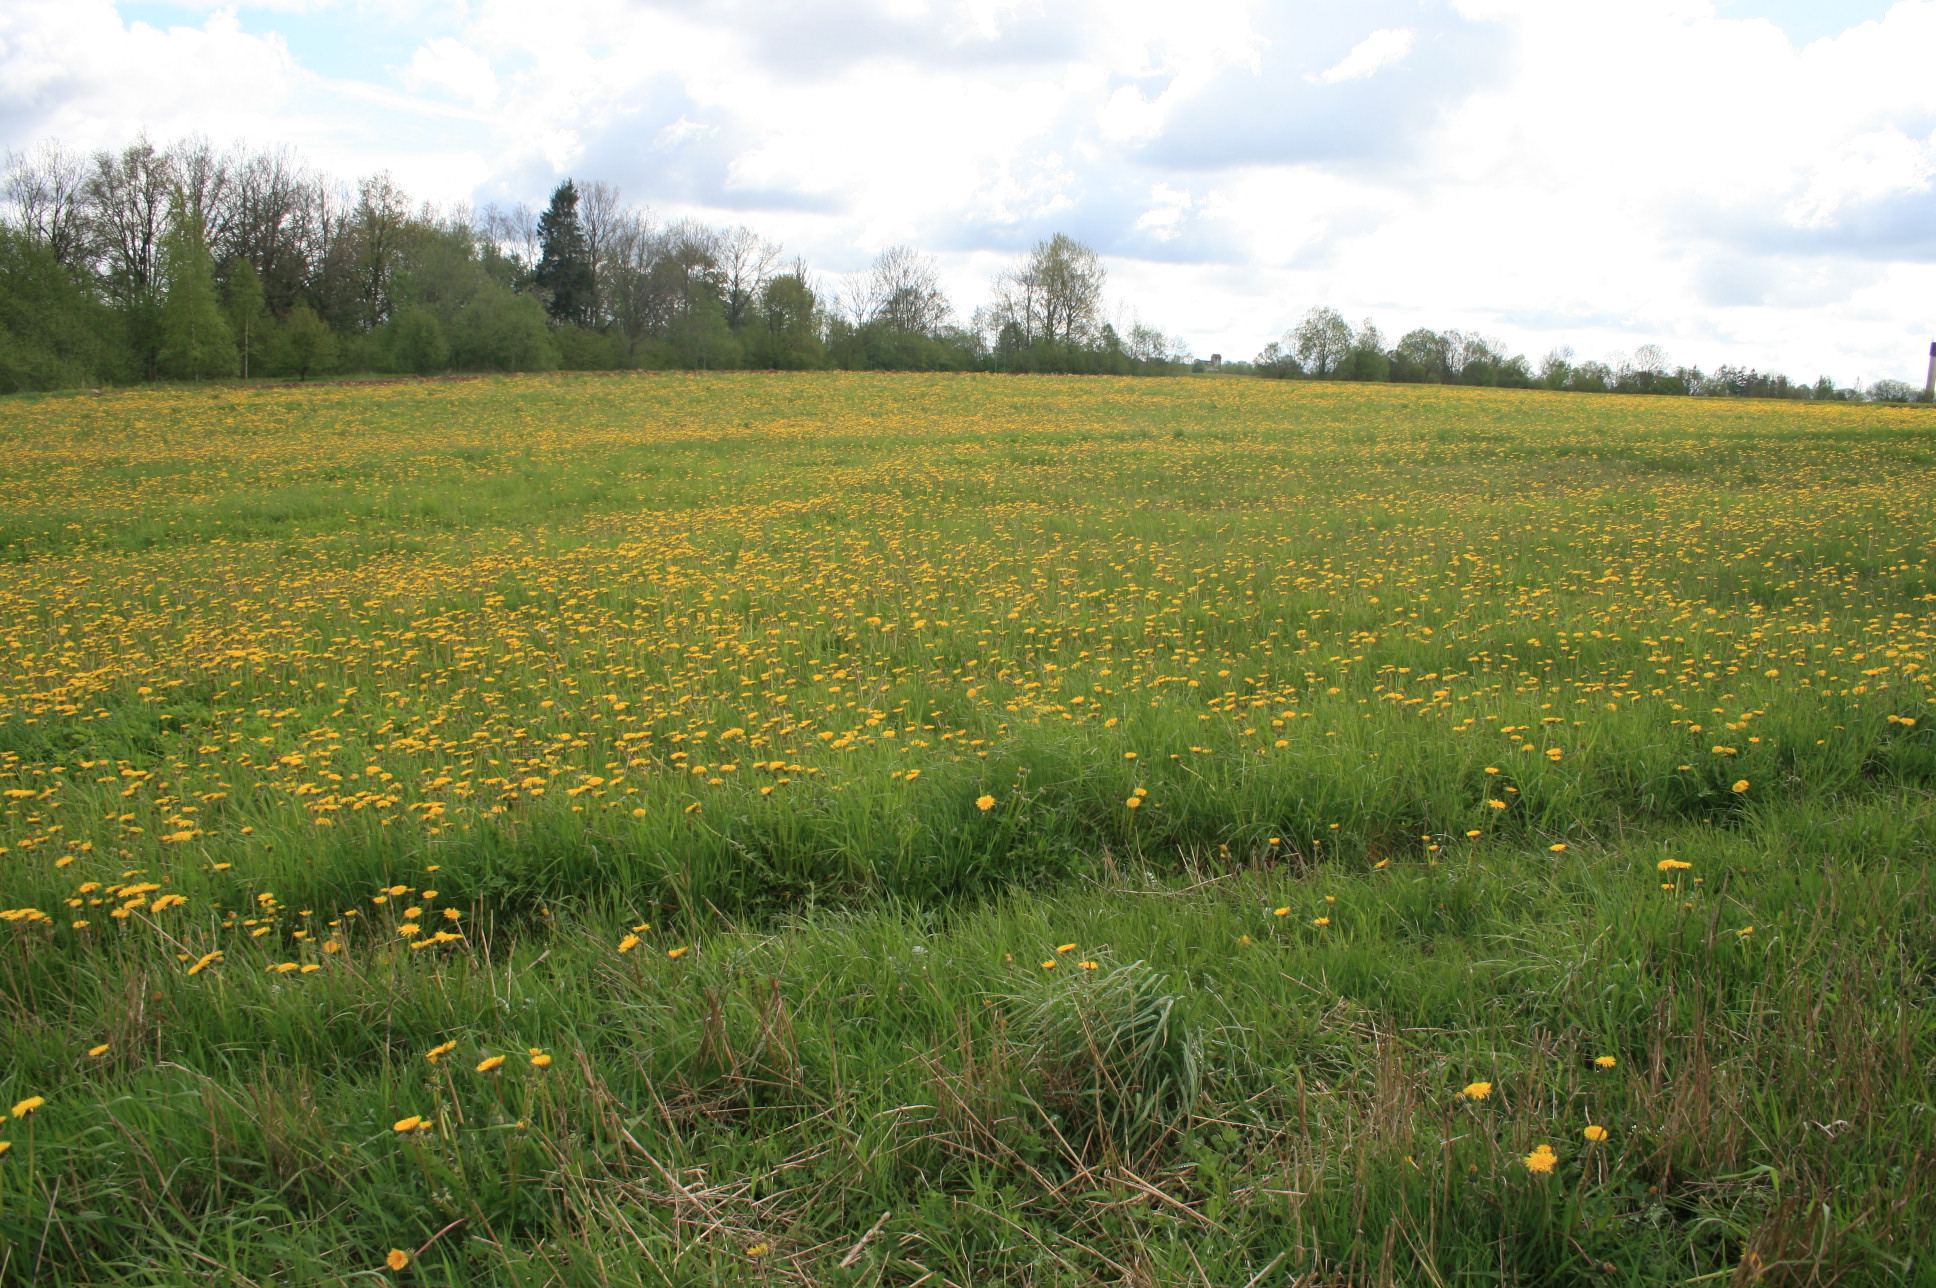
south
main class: Grassland
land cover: Grassland without tree/shrub cover
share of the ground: > 75 %
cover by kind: herbaceous plants 100 %
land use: Agriculture (excluding fallow land and kitchen gardens)
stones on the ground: < 10 %
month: May
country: LT
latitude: 56.2521
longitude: 22.0759
